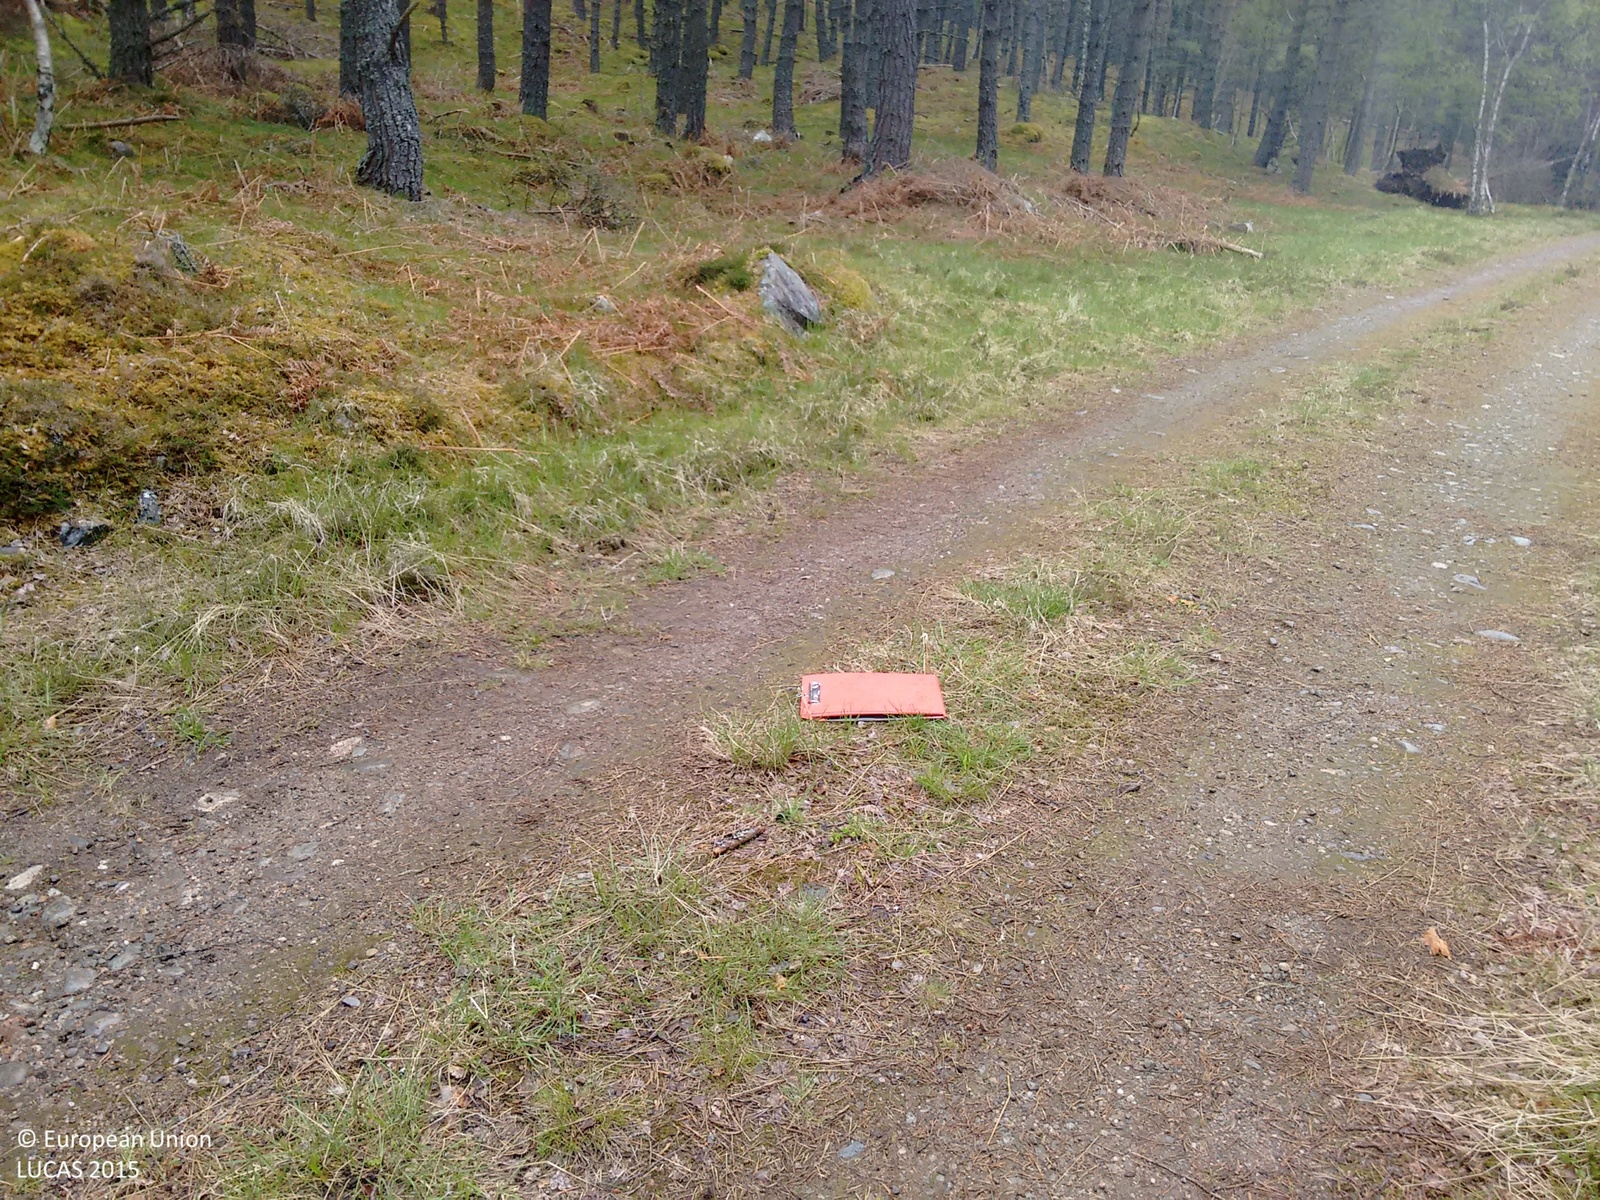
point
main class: Woodland
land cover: Pine dominated coniferous woodland
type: exotic forest
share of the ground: > 75 %
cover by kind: coniferous forest trees 70 %, lichens and mosses 10 %, consolidated bare surface 10 %, broadleaved forest trees 5 %, shrubs 5 %
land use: Forestry
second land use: Amenities, museums, leisure
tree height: > 5 m
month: June
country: GB
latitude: 57.2451
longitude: -3.8159
